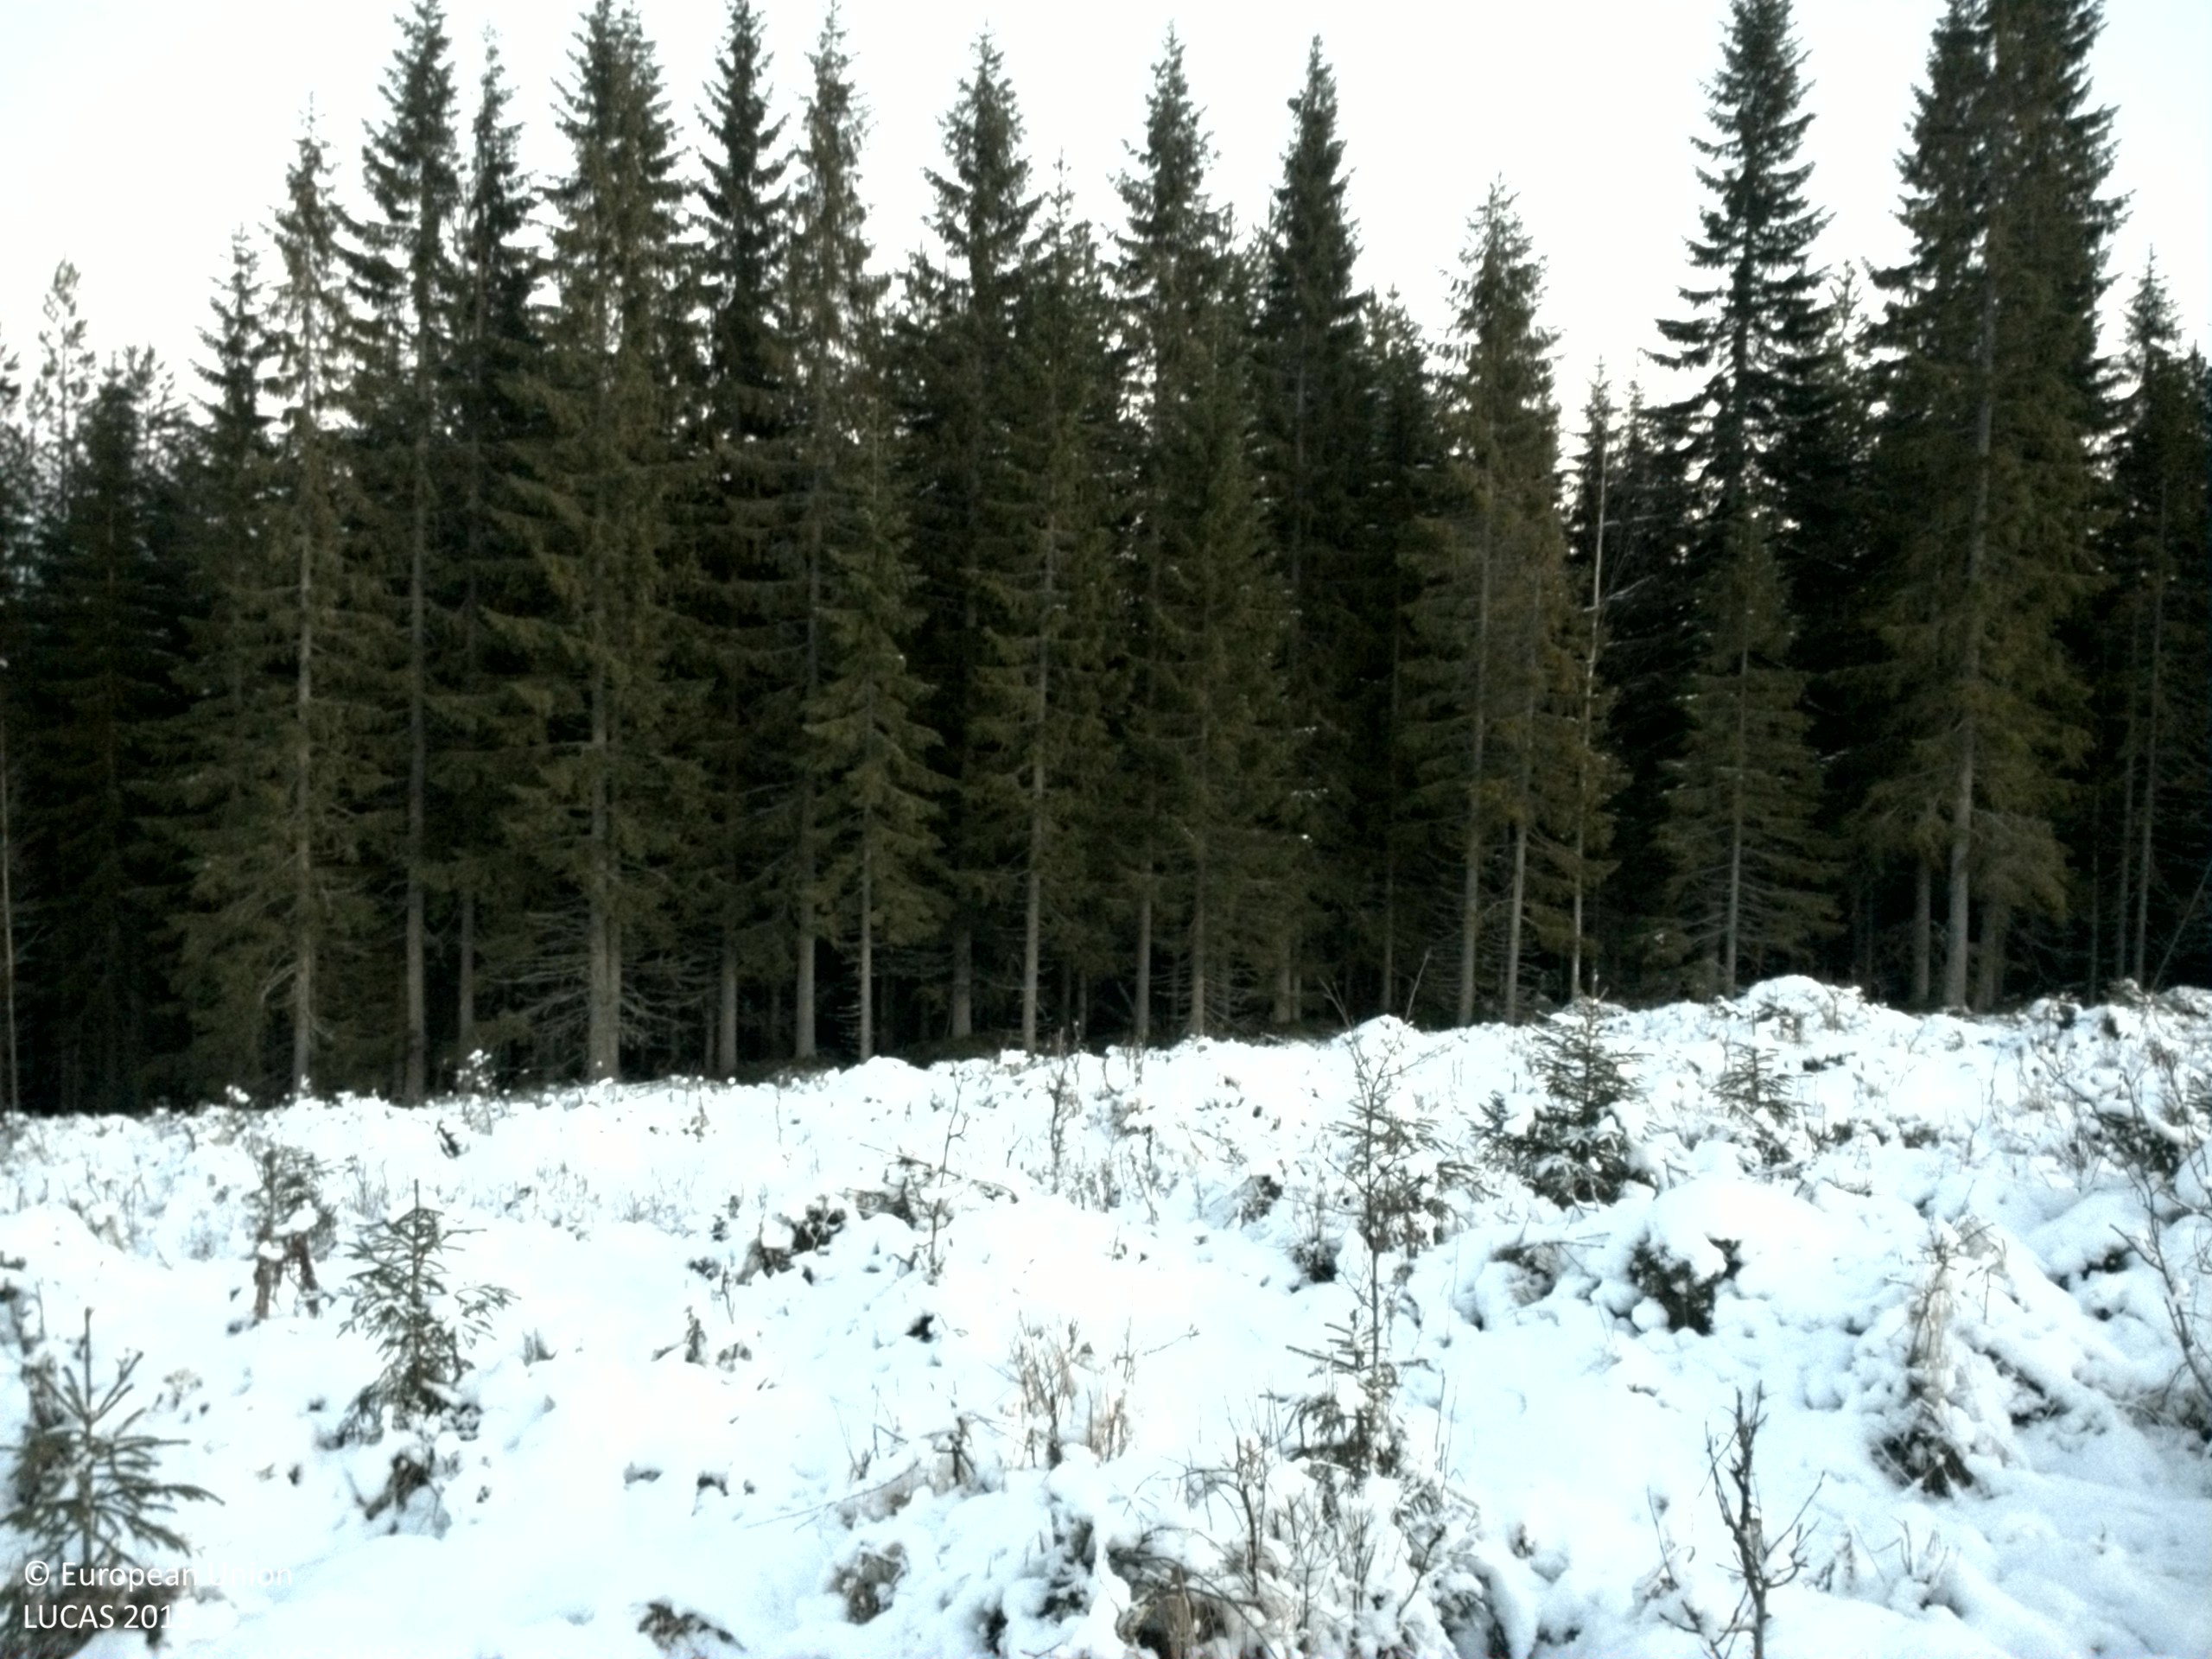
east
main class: Woodland
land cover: Spruce dominated mixed woodland
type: boreal forest
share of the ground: 10 - 25 %
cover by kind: herbaceous plants 35 %, shrubs 25 %, broadleaved forest trees 15 %, lichens and mosses 15 %, coniferous forest trees 5 %
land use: Electricity, gas and thermal power distribution
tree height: < 5 m
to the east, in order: Spruce dominated mixed woodland; Electric lines; Spruce dominated mixed woodland; Spruce dominated coniferous woodland; Pine dominated coniferous woodland; Spruce dominated coniferous woodland; Rivers and streams; Spruce dominated coniferous woodland
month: November
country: SE
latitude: 62.0417
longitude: 15.5074
